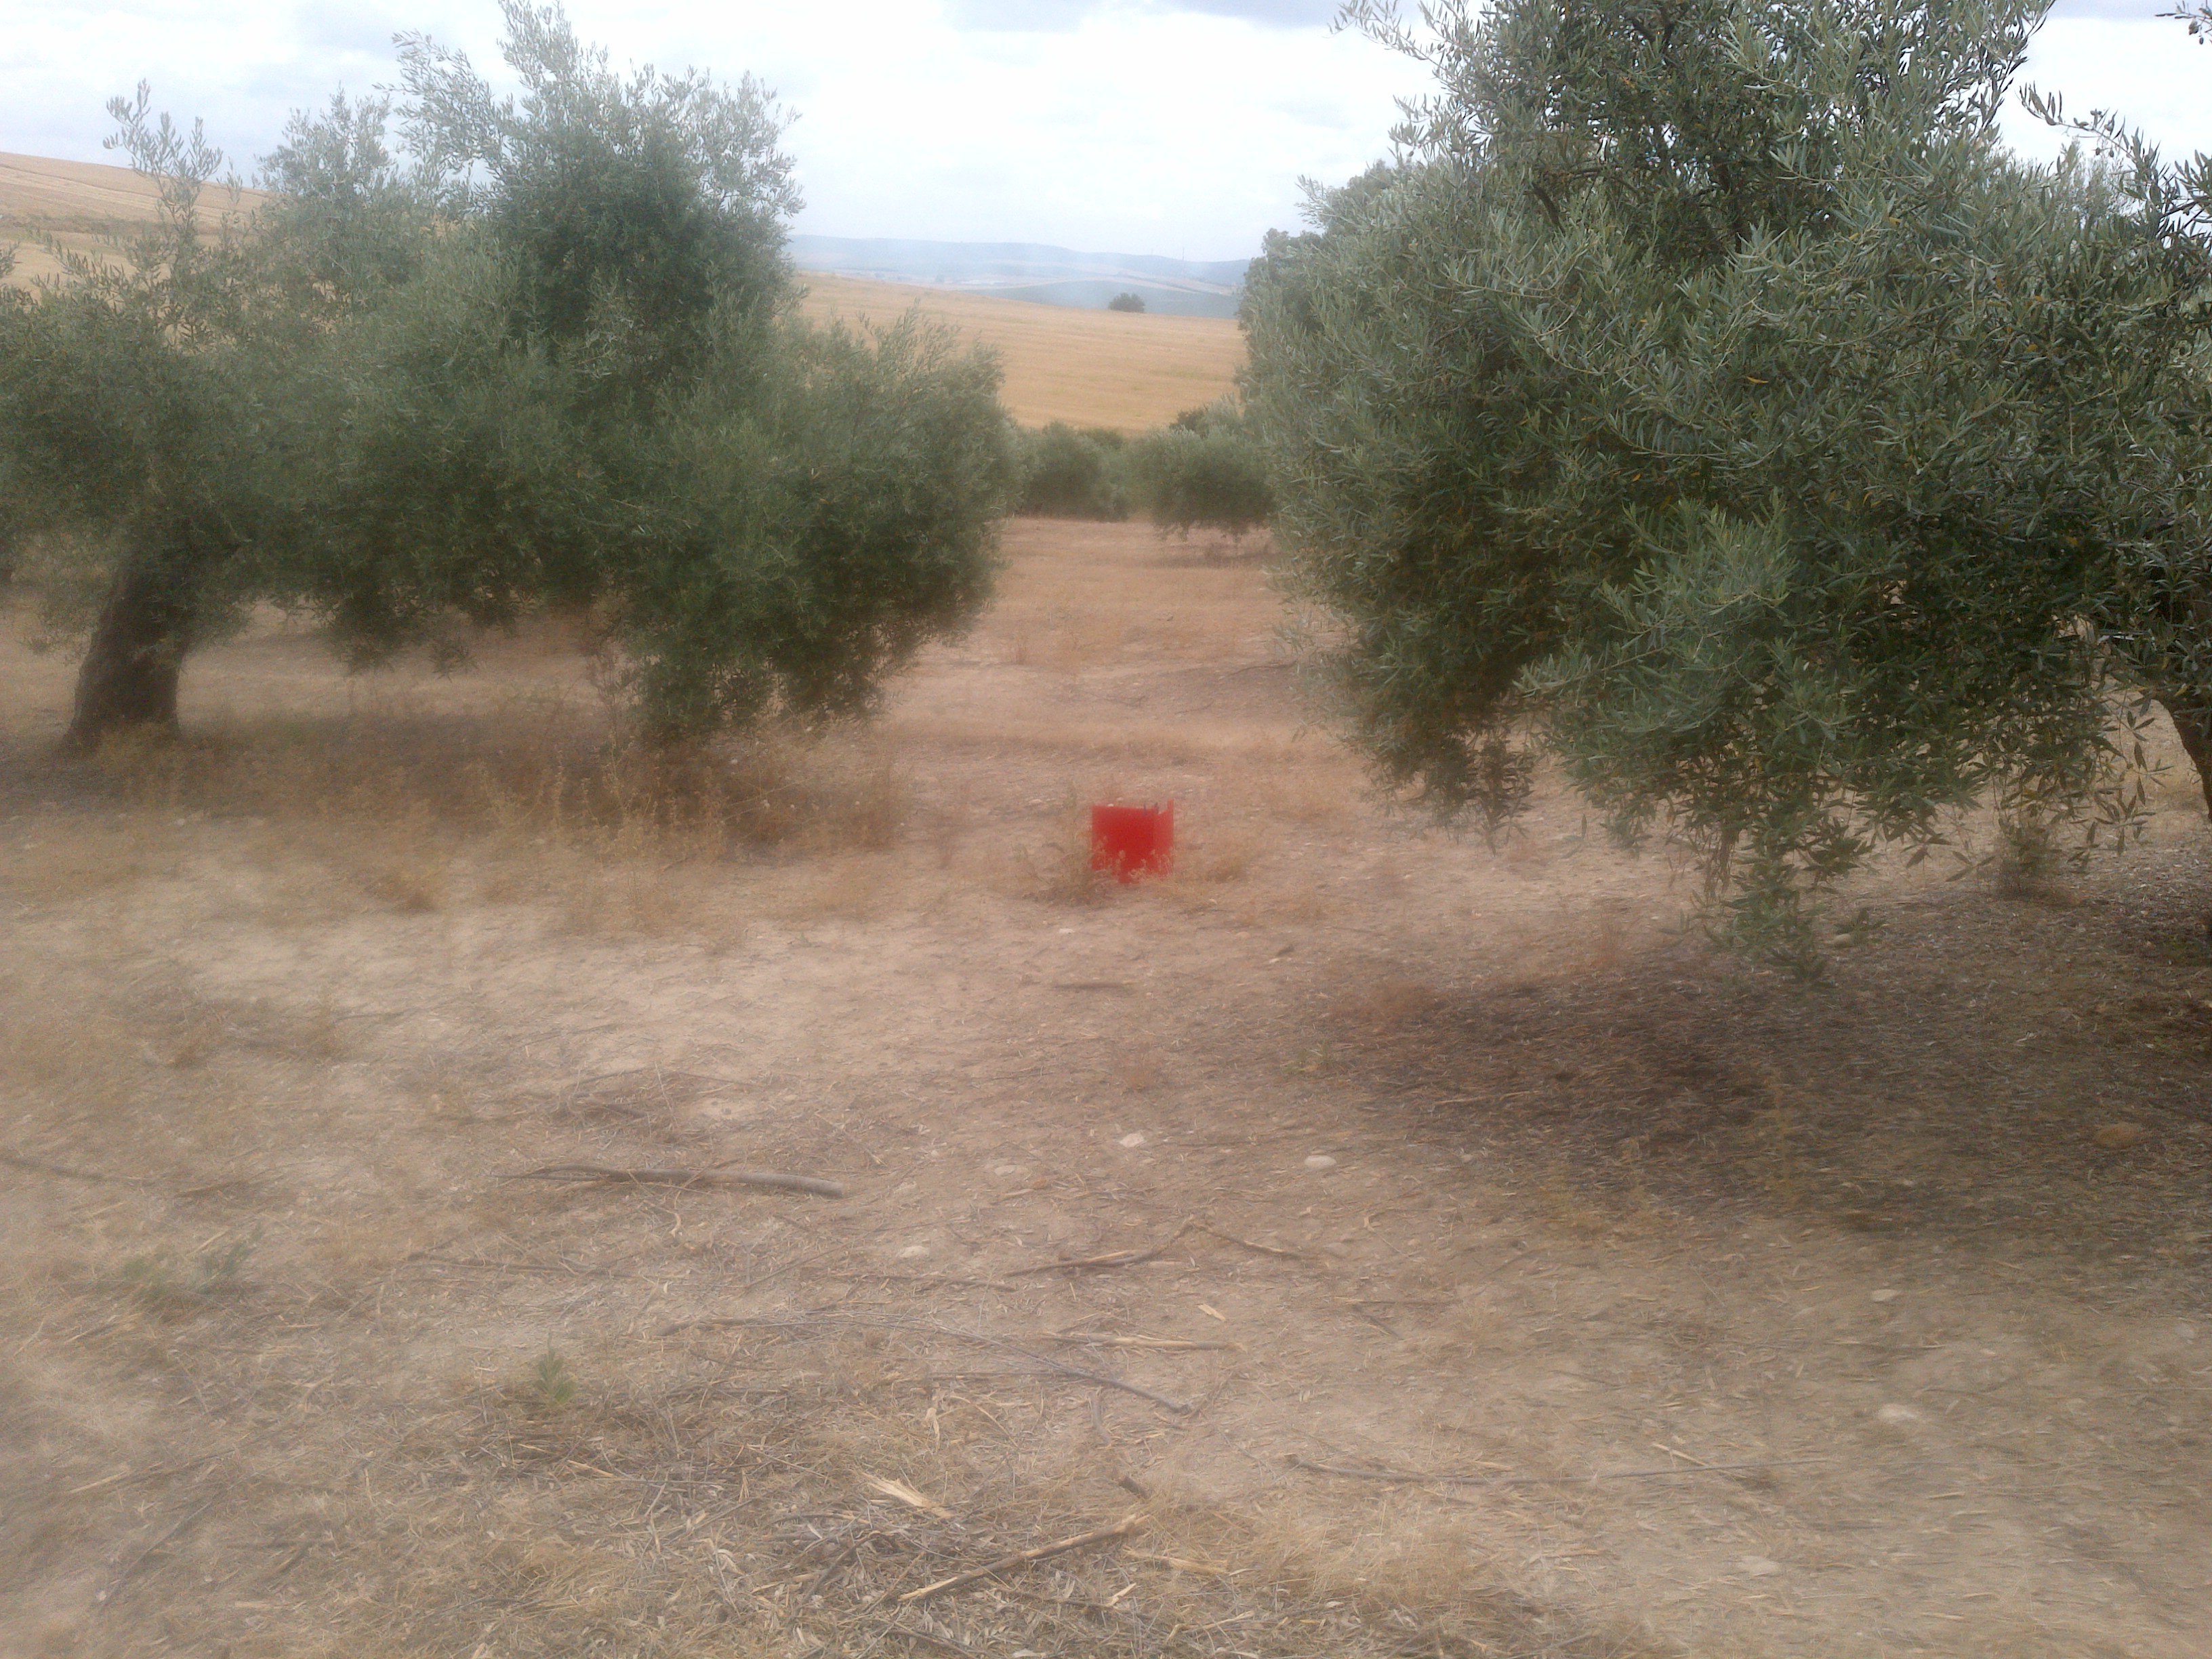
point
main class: Cropland
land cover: Olive groves
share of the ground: 50 - 75 %
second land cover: Spontaneously vegetated surfaces
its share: 10 - 25 %
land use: Agriculture (excluding fallow land and kitchen gardens)
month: June
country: ES
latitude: 37.9747
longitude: -4.4811
